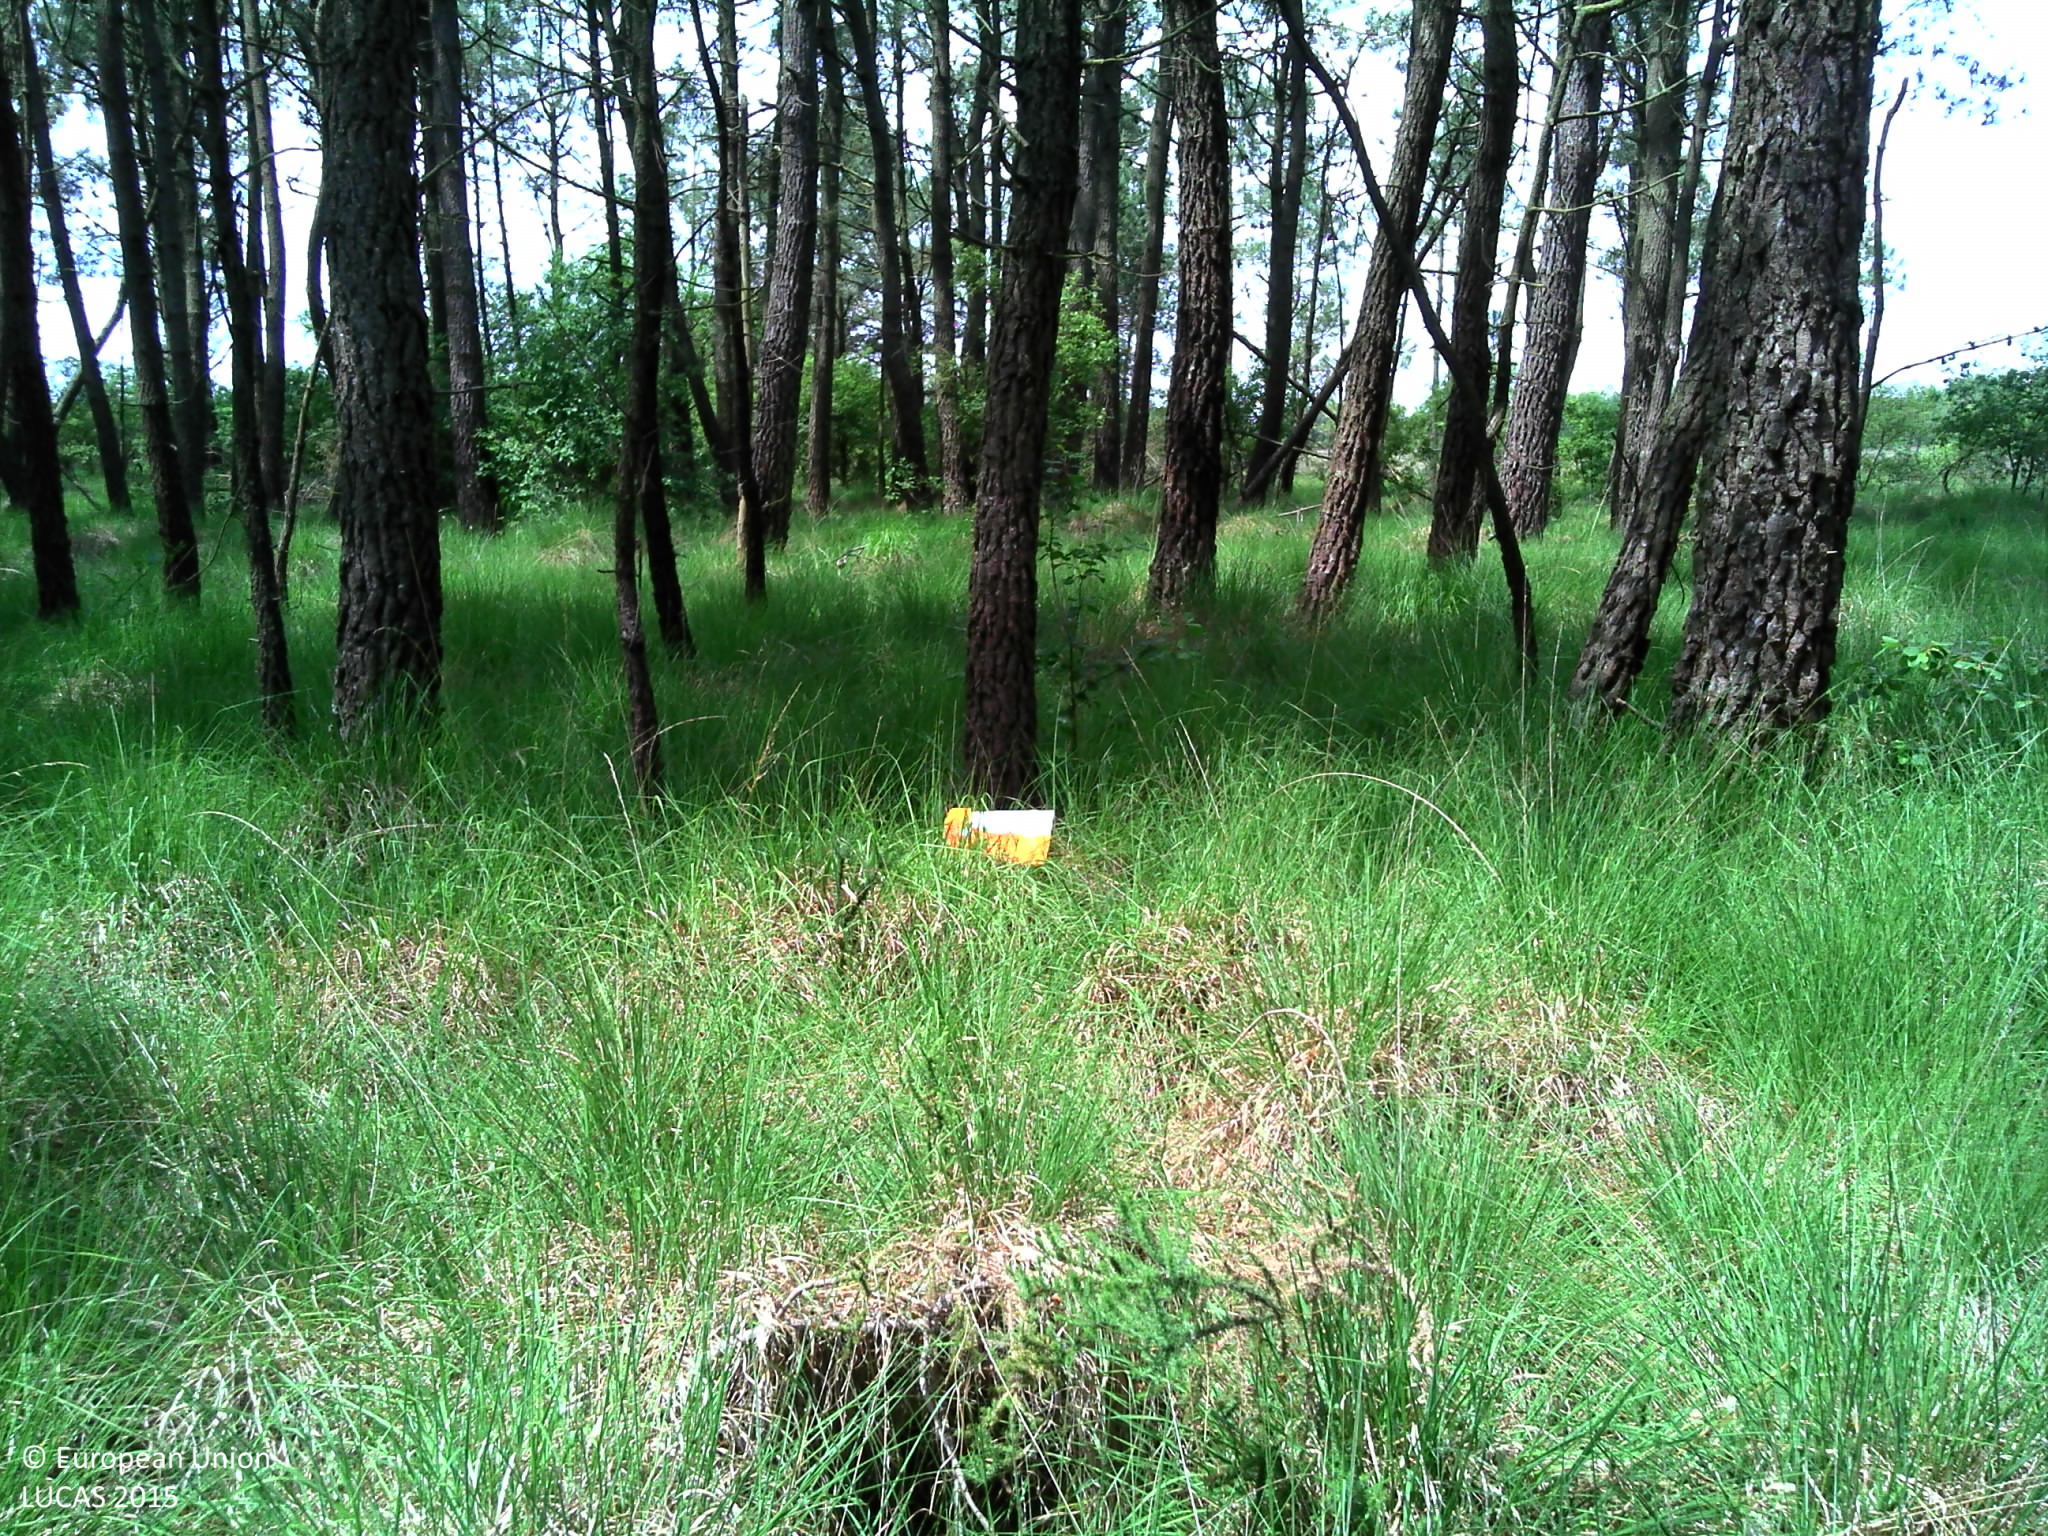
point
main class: Woodland
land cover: Pine dominated coniferous woodland
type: hemiboreal forest and nemoral coniferous forest and mixed broadleaved-coniferous forest
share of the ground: > 75 %
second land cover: Spontaneously vegetated surfaces
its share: > 75 %
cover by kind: coniferous forest trees 90 %, herbaceous plants 10 %
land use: Forestry
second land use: Fallow land
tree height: > 5 m
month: June
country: FR
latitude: 49.1491
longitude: -1.4687
